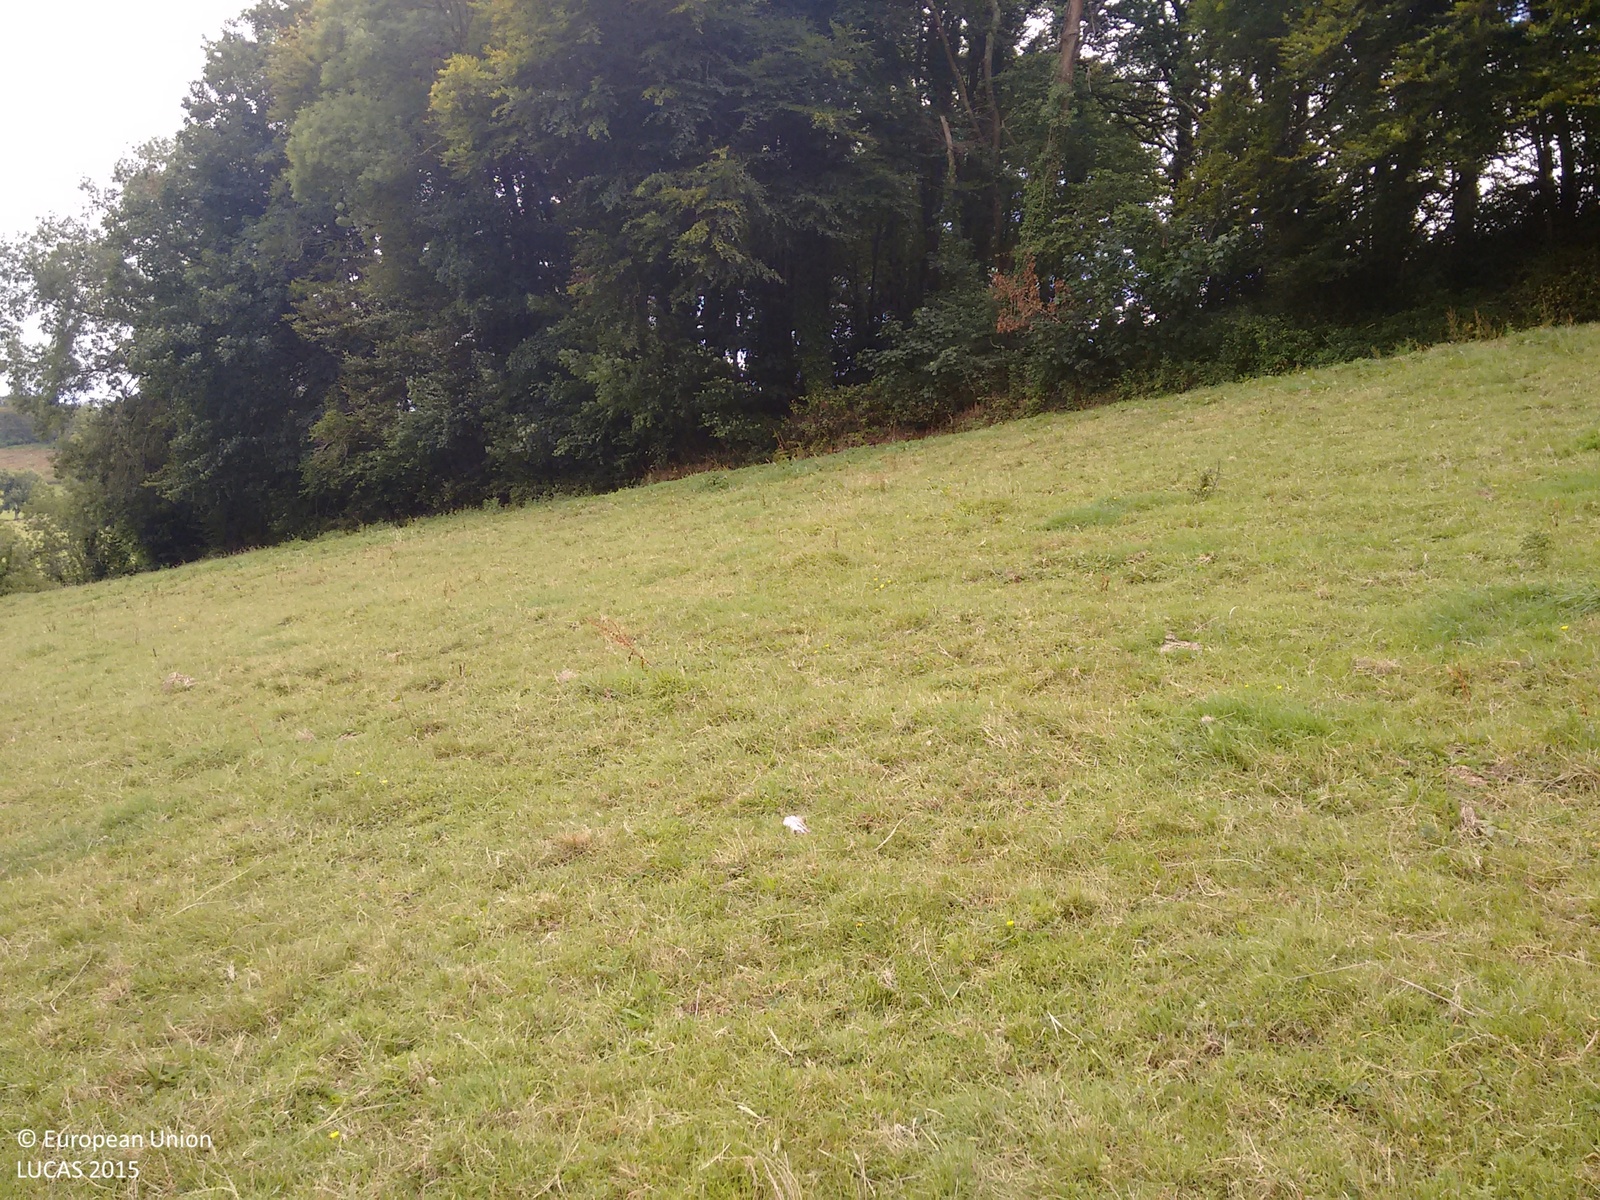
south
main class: Grassland
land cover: Grassland without tree/shrub cover
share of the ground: > 75 %
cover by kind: herbaceous plants 100 %
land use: Agriculture (excluding fallow land and kitchen gardens)
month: July
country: GB
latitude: 50.4144
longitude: -3.6671
